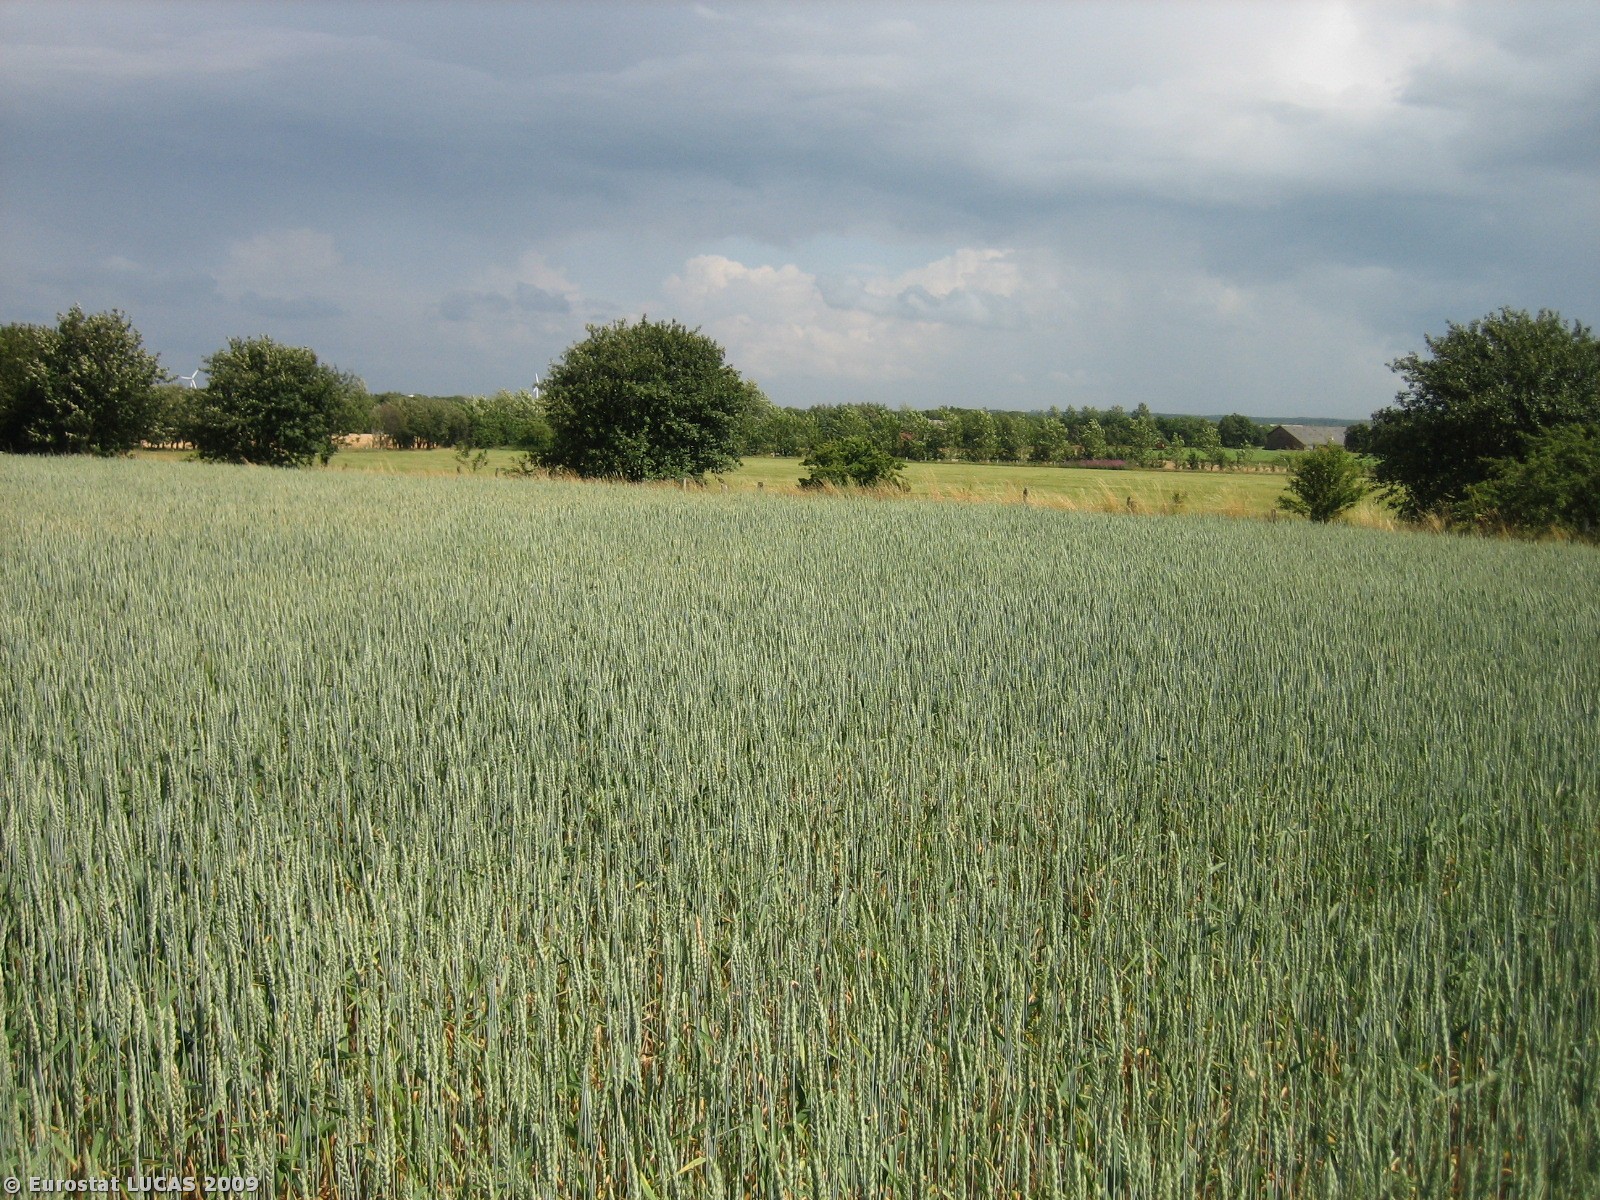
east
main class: Cropland
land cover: Common wheat
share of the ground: > 75 %
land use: Agriculture (excluding fallow land and kitchen gardens)
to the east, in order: Common wheat; Grass margins; Paved roads, cycling and walking lanes; Grass margins; Fences; Grassland without tree/shrub cover; Railways; Single bushes/trees; Fences; Barley; Grass margins; Broadleaved woodland; Fences; Grassland without tree/shrub cover
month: July
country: DK
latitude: 55.6070
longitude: 8.8106
